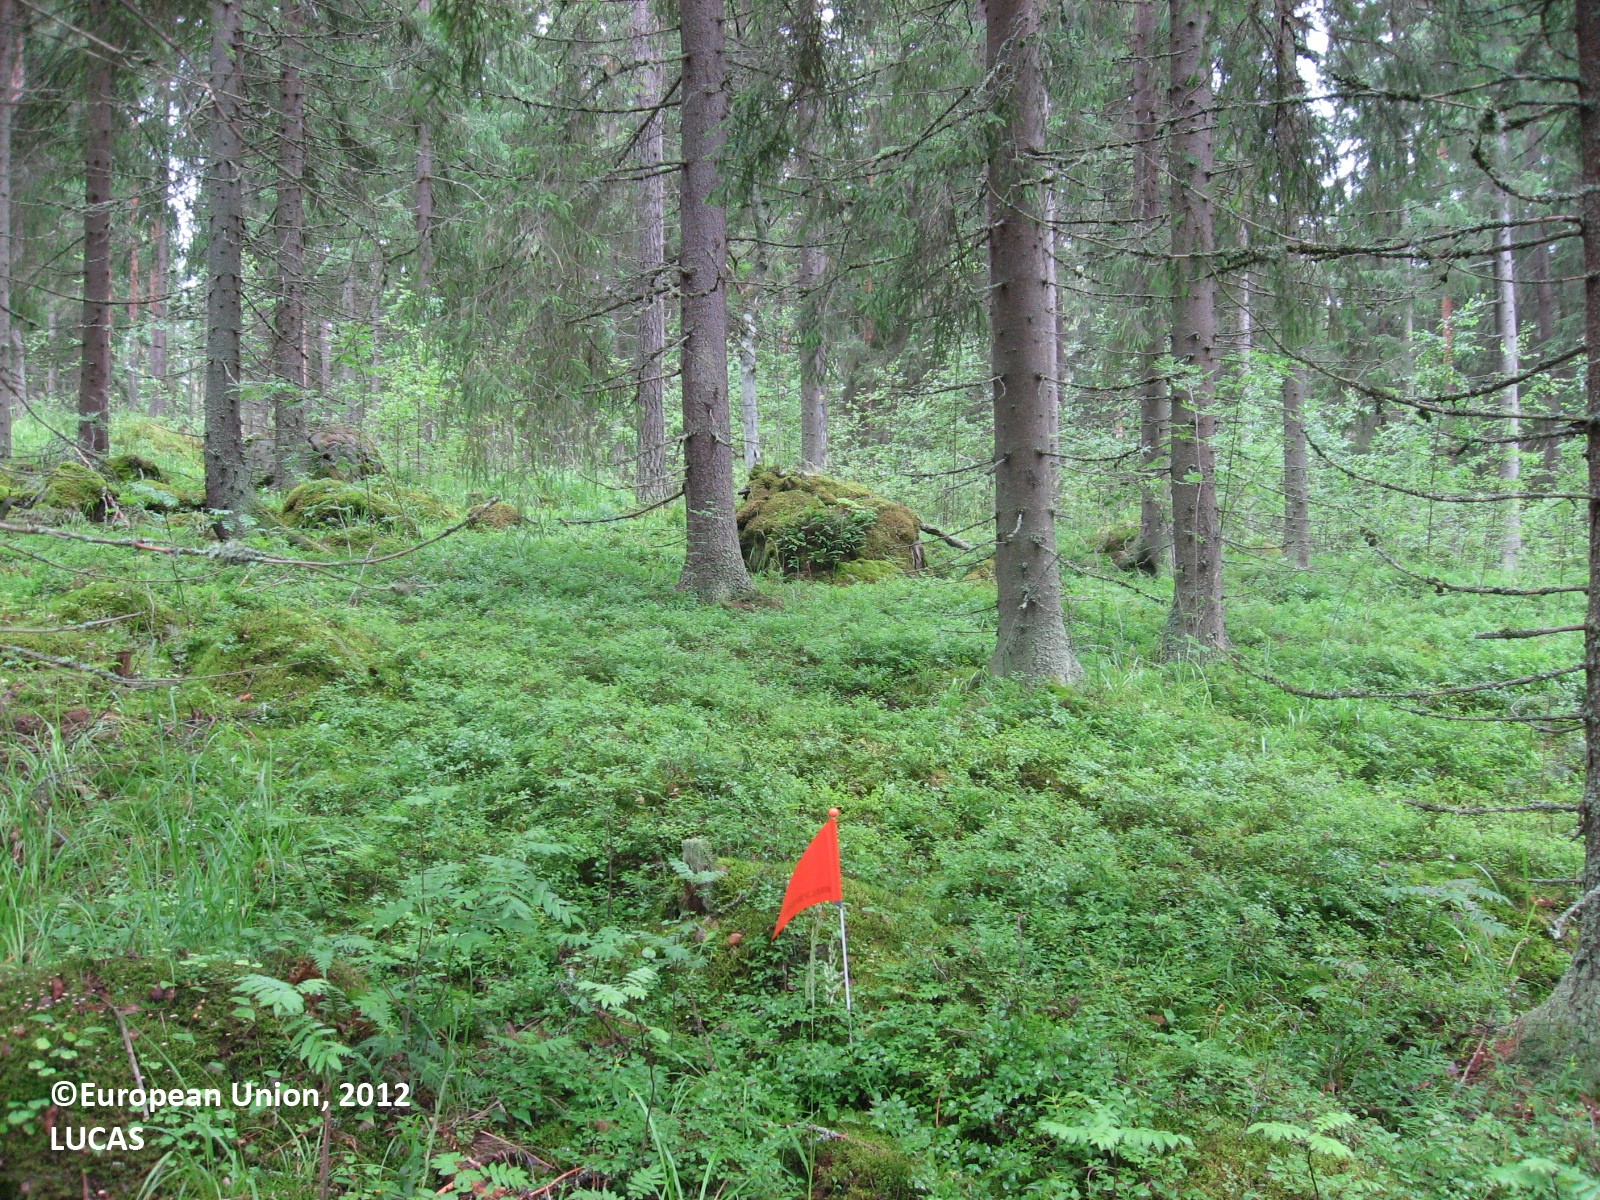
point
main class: Woodland
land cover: Spruce dominated coniferous woodland
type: boreal forest
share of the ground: 50 - 75 %
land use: Forestry
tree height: > 5 m
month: July
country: FI
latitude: 61.2271
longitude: 25.8700
